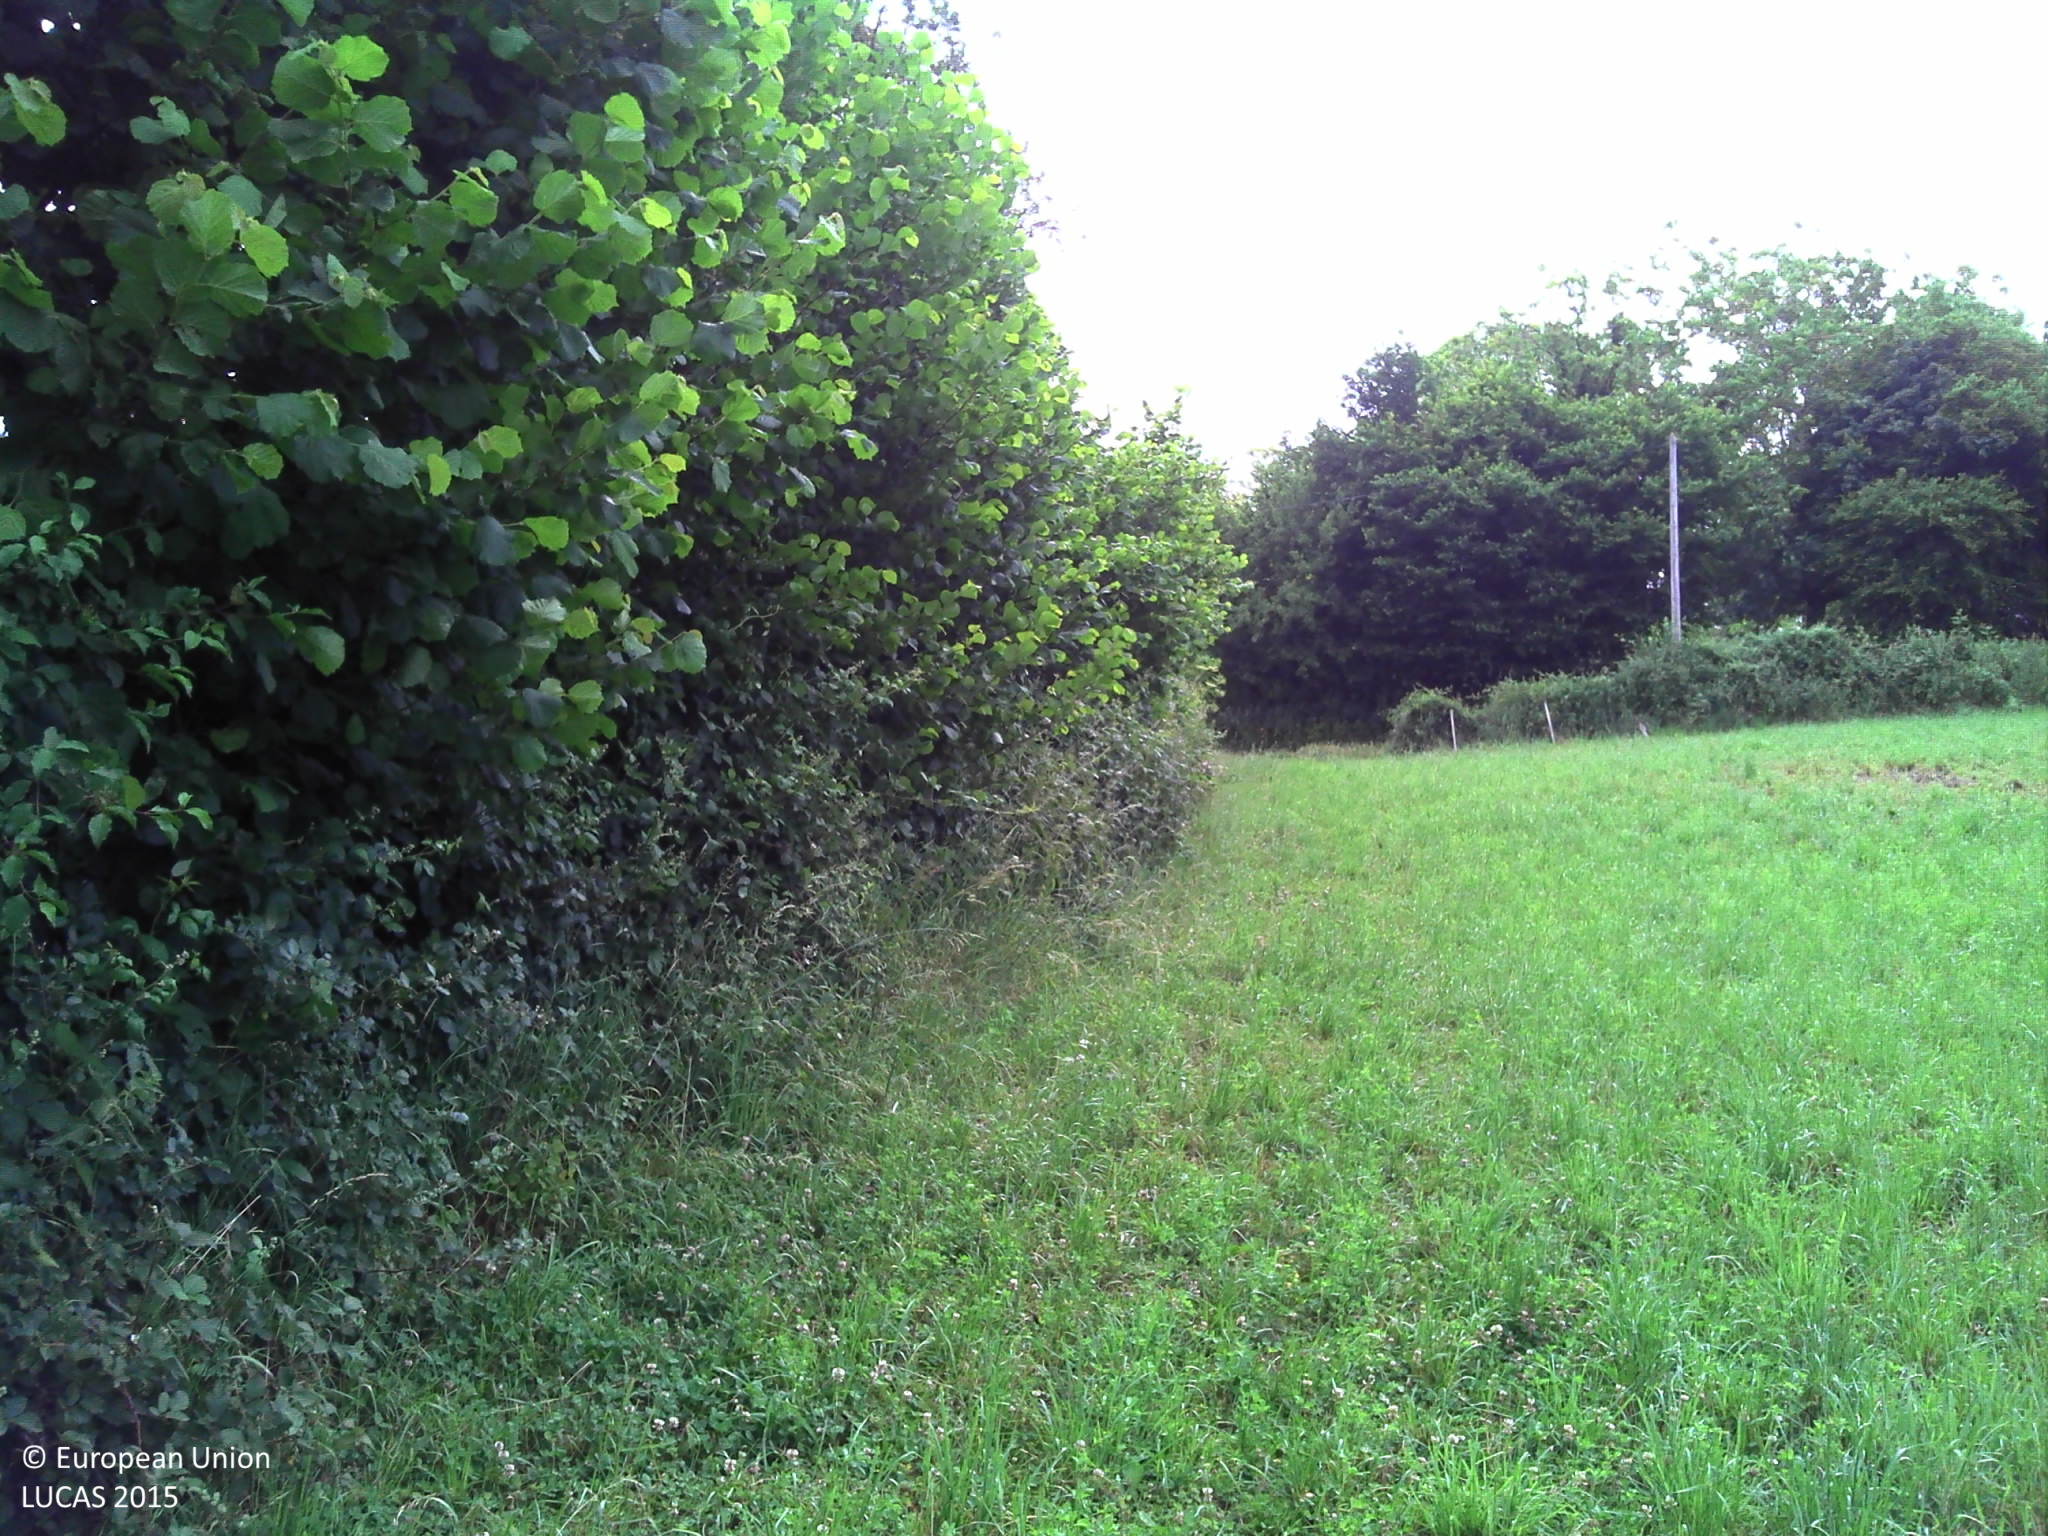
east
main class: Cropland
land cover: Barley
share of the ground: > 75 %
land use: Agriculture (excluding fallow land and kitchen gardens)
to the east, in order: Managed hedges; Barley; Managed hedges; Fences; Electric lines; Grass margins; Paved roads, cycling and walking lanes; Grass margins; Grassland with sparse tree/shrub cover; Dry stone walls; Grassland with sparse tree/shrub cover; Fences; Shrubland with sparse tree cover; Broadleaved woodland
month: June
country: FR
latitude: 44.2062
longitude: 2.5077
